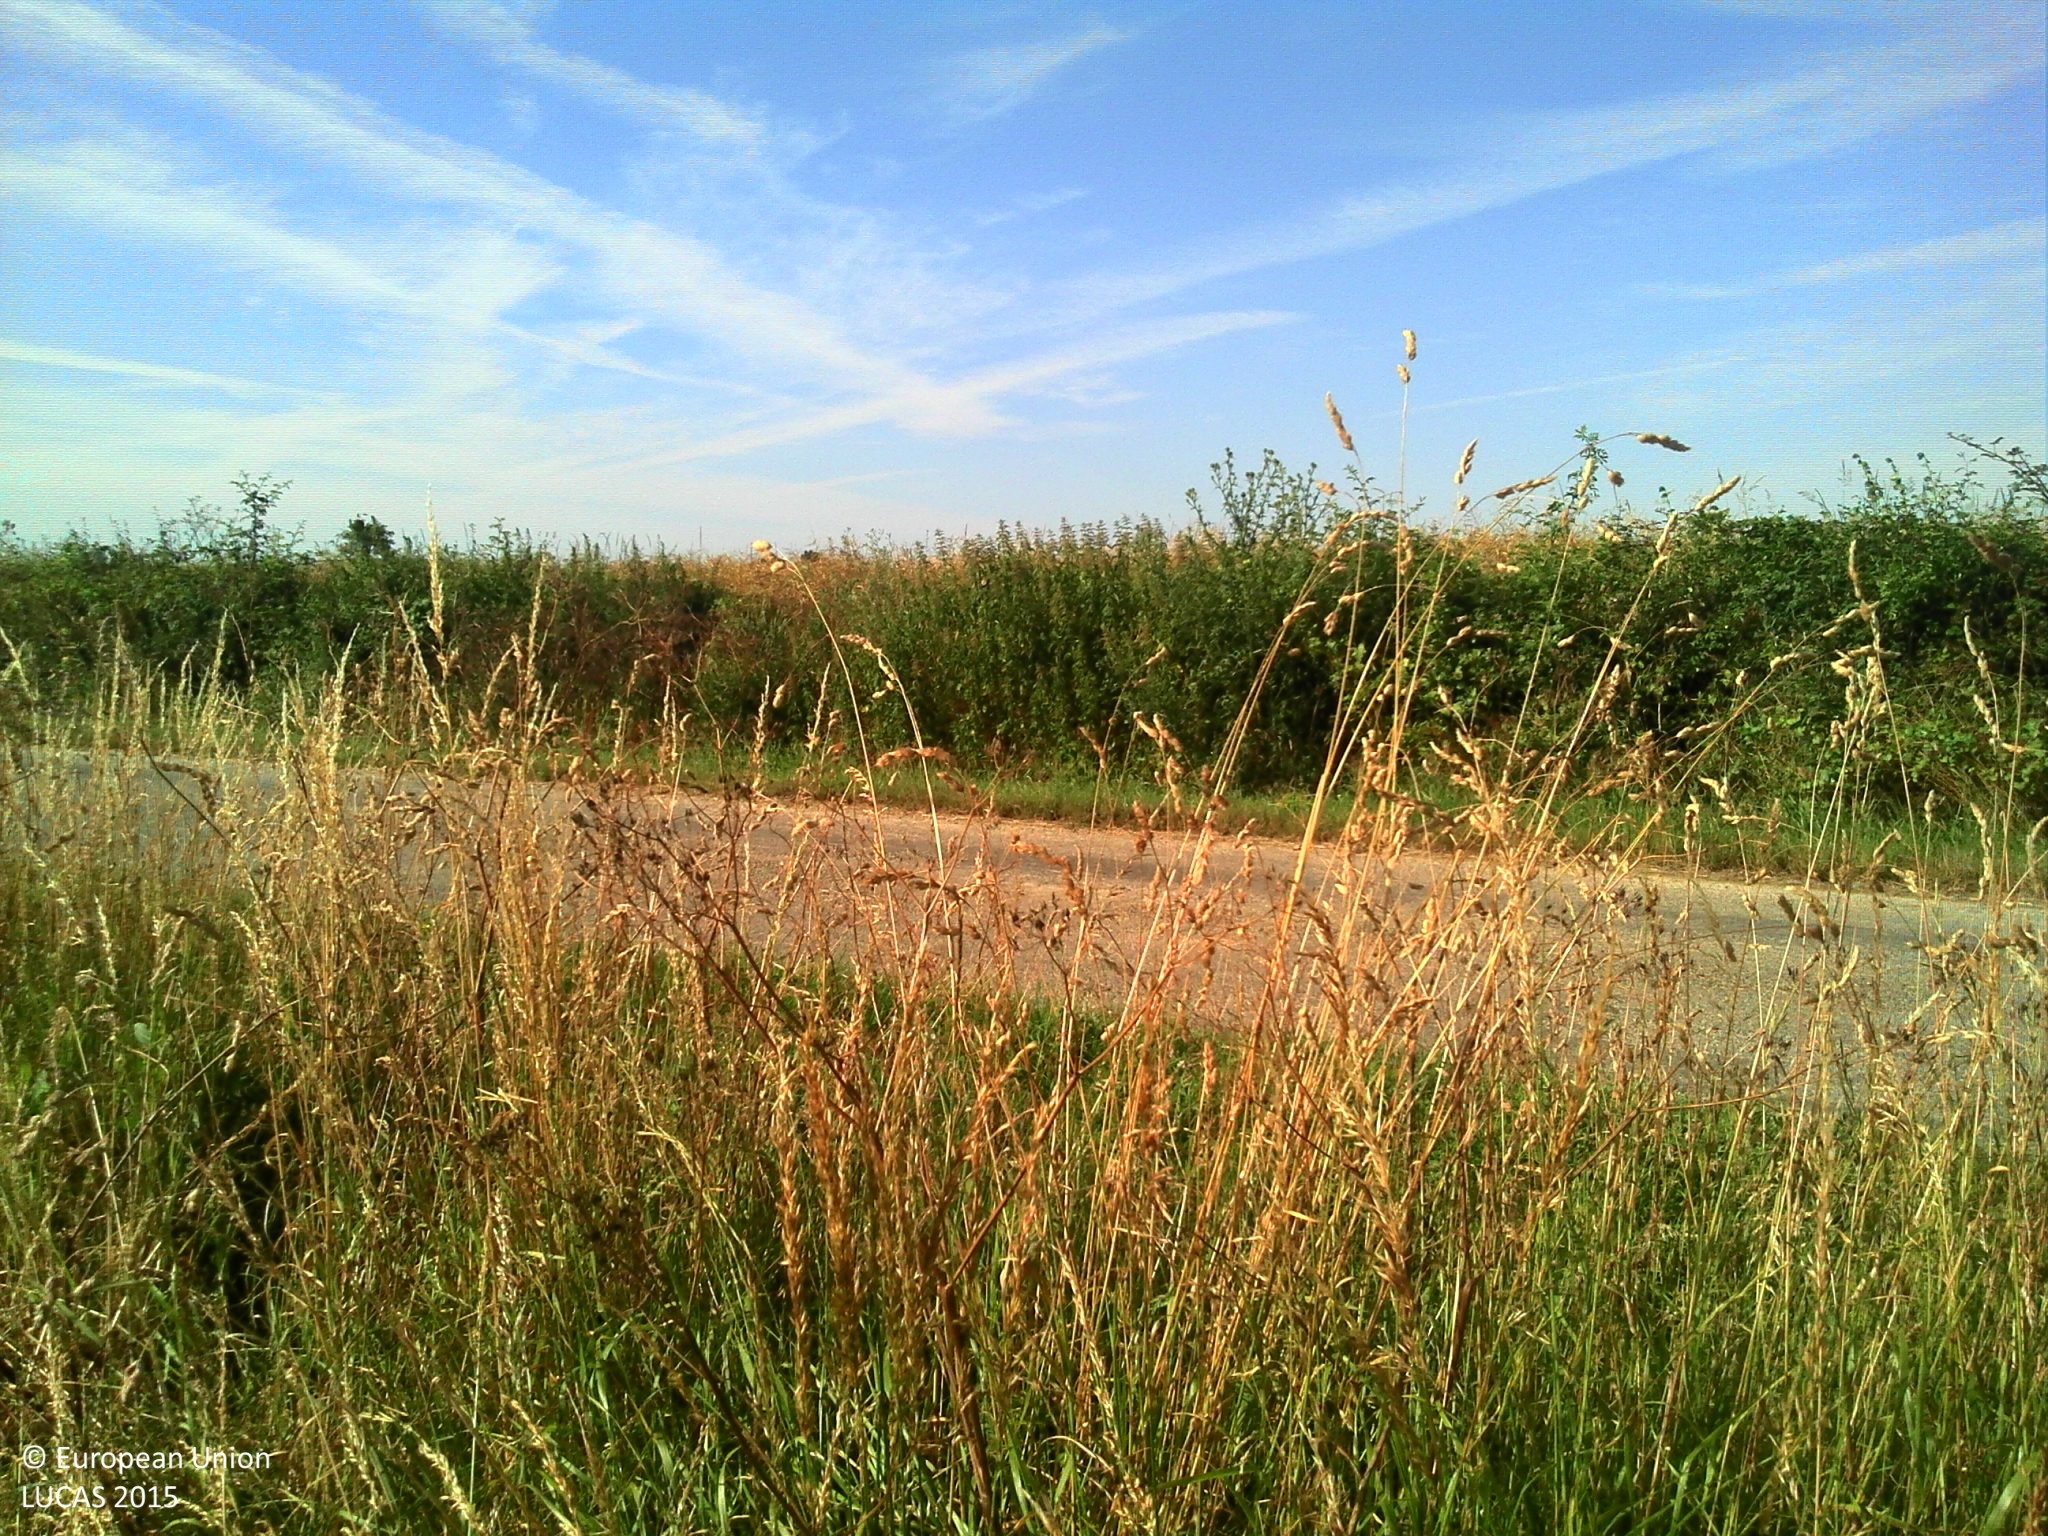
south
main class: Cropland
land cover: Maize
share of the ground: > 75 %
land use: Agriculture (excluding fallow land and kitchen gardens)
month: June
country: FR
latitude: 46.5029
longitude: 0.2463
